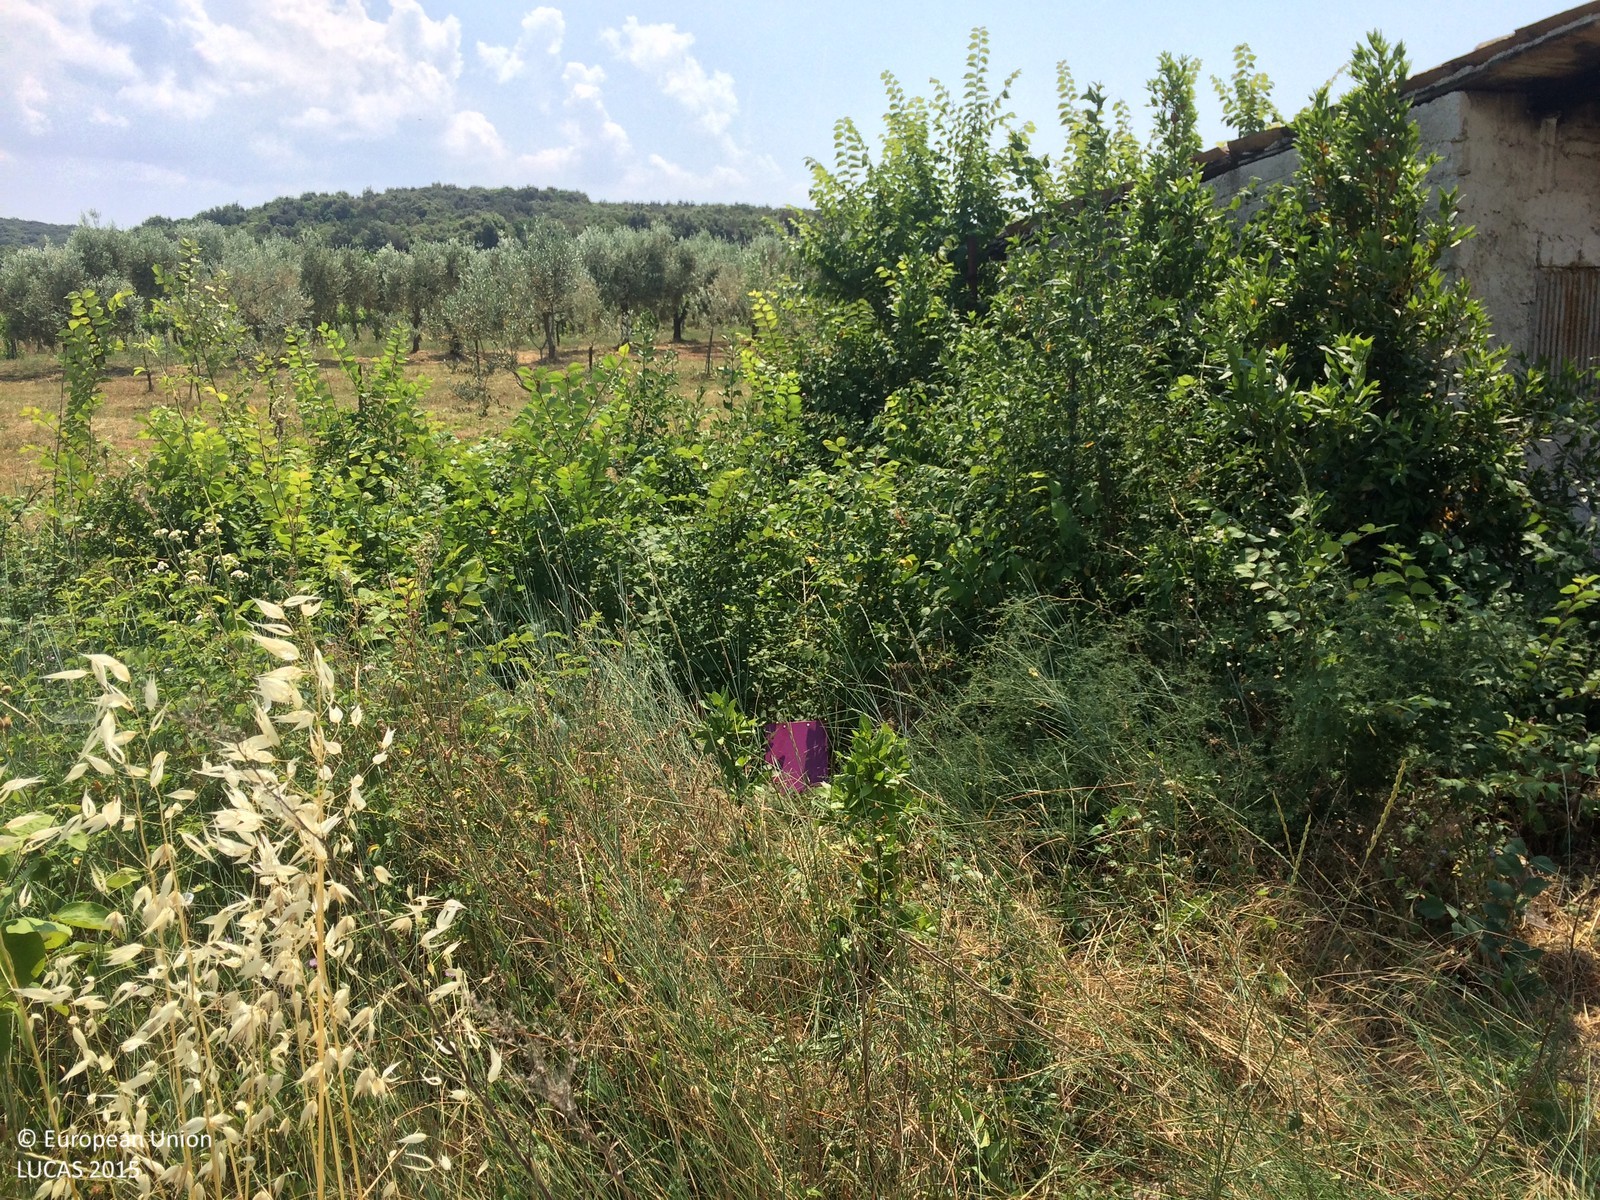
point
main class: Shrubland
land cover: Shrubland without tree cover
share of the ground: < 10 %
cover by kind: herbaceous plants 90 %, shrubs 10 %
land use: Semi-natural and natural areas not in use
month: June
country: HR
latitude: 45.1168
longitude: 13.6429
